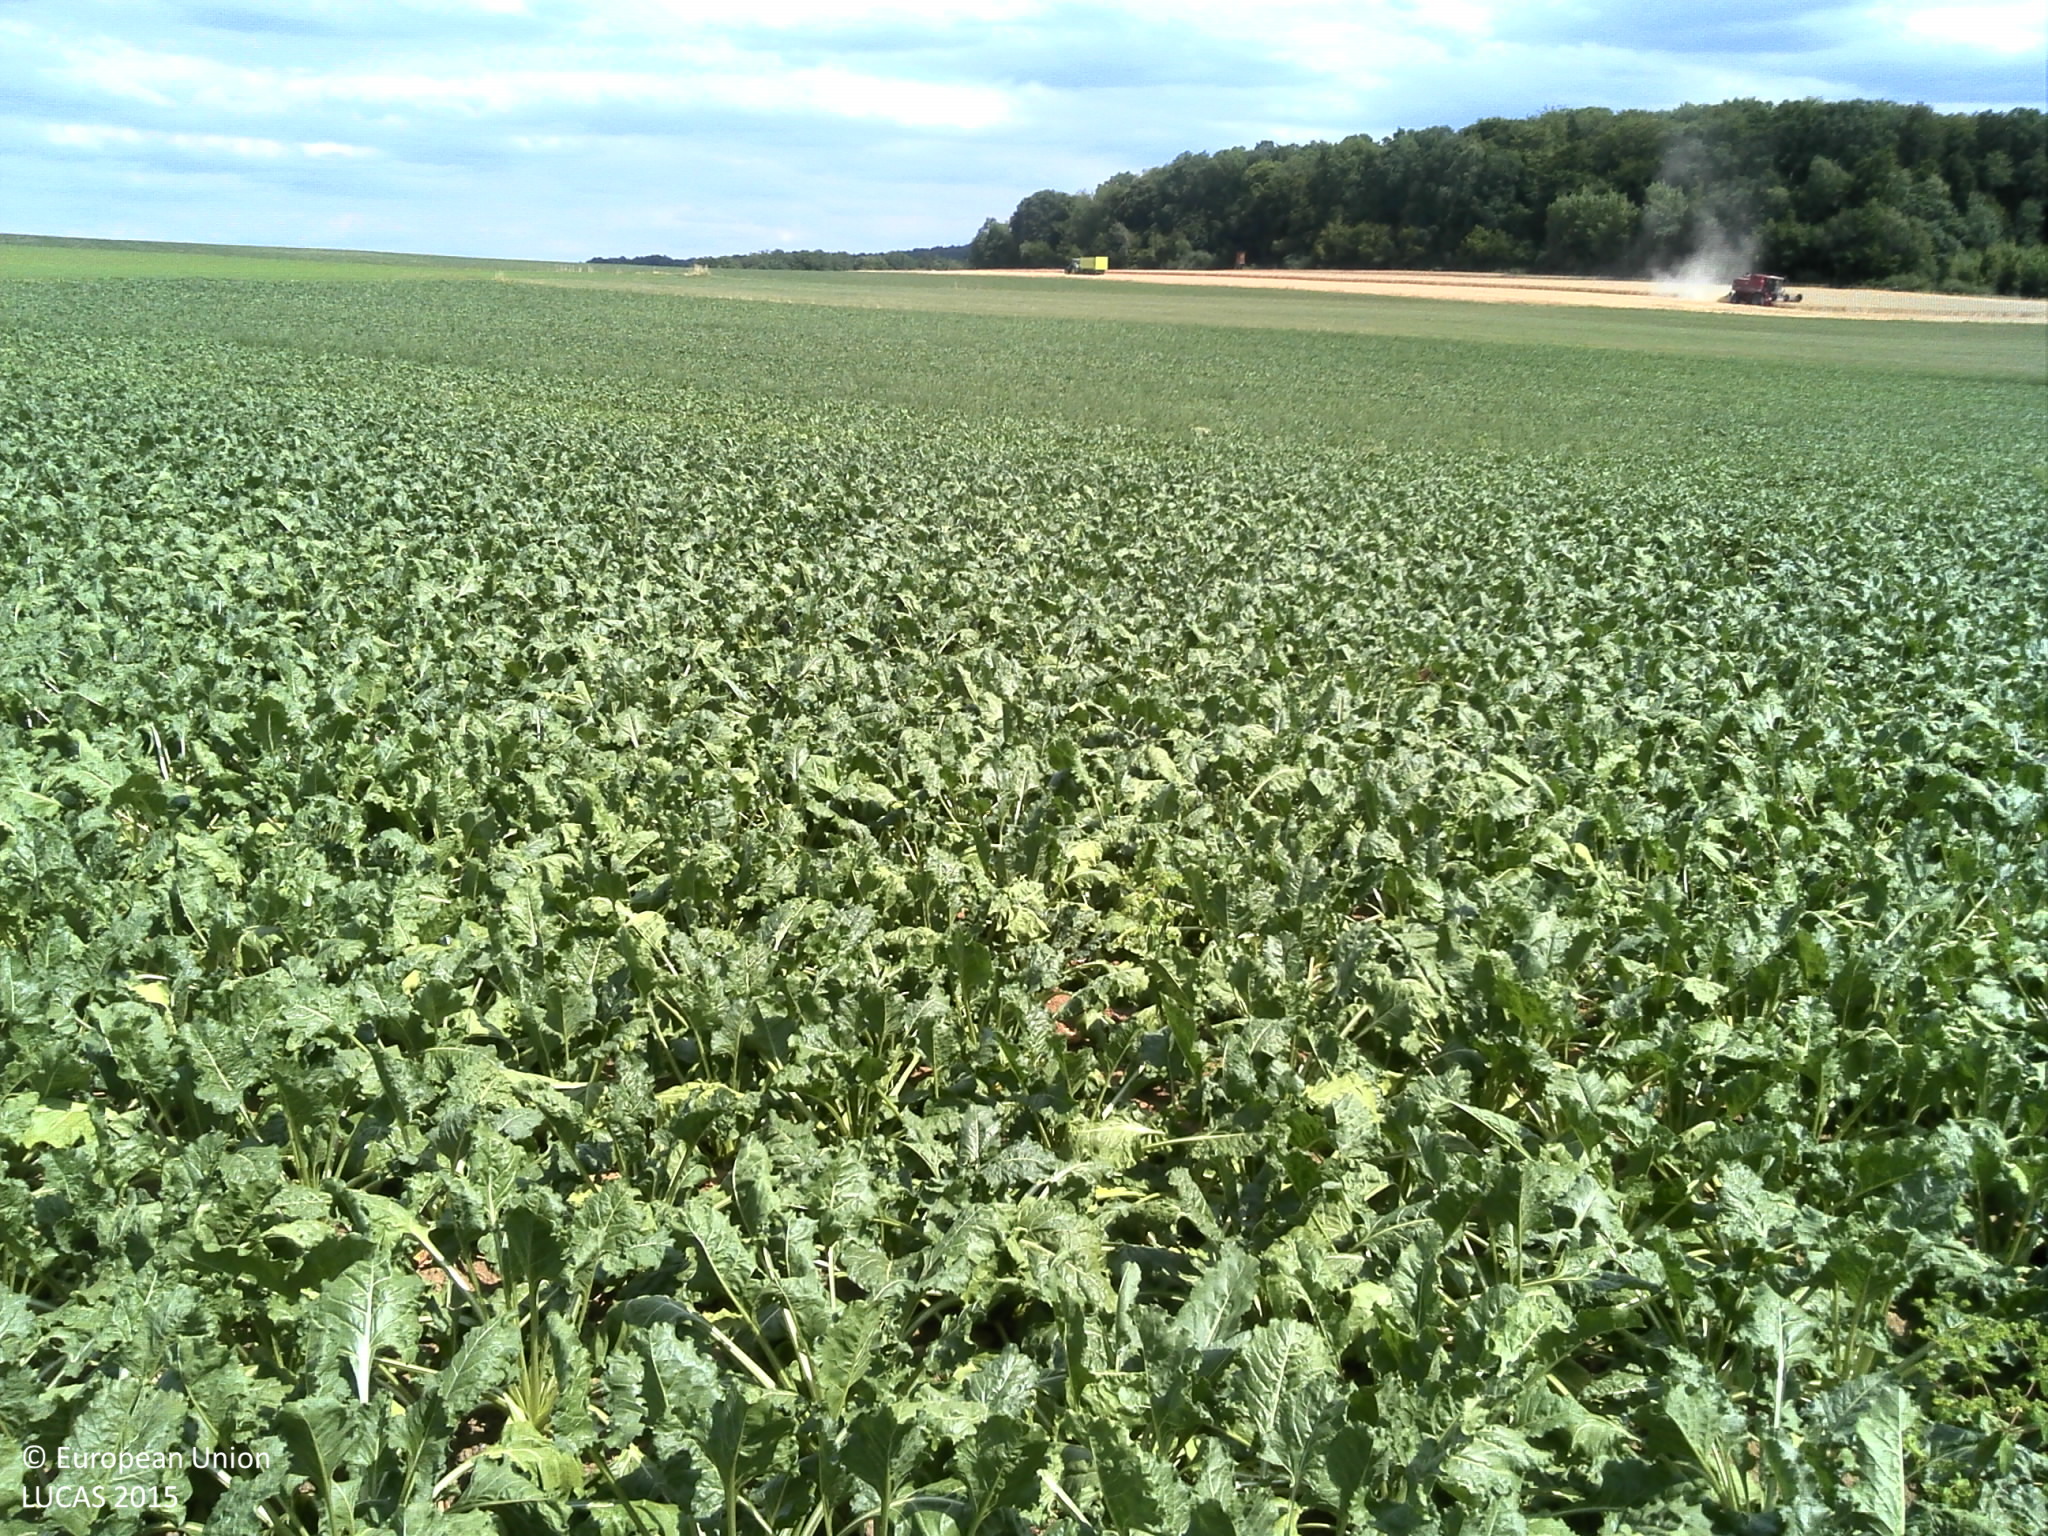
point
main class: Cropland
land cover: Sugar beet
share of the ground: > 75 %
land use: Agriculture (excluding fallow land and kitchen gardens)
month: July
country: FR
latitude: 49.1670
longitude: 7.4907
